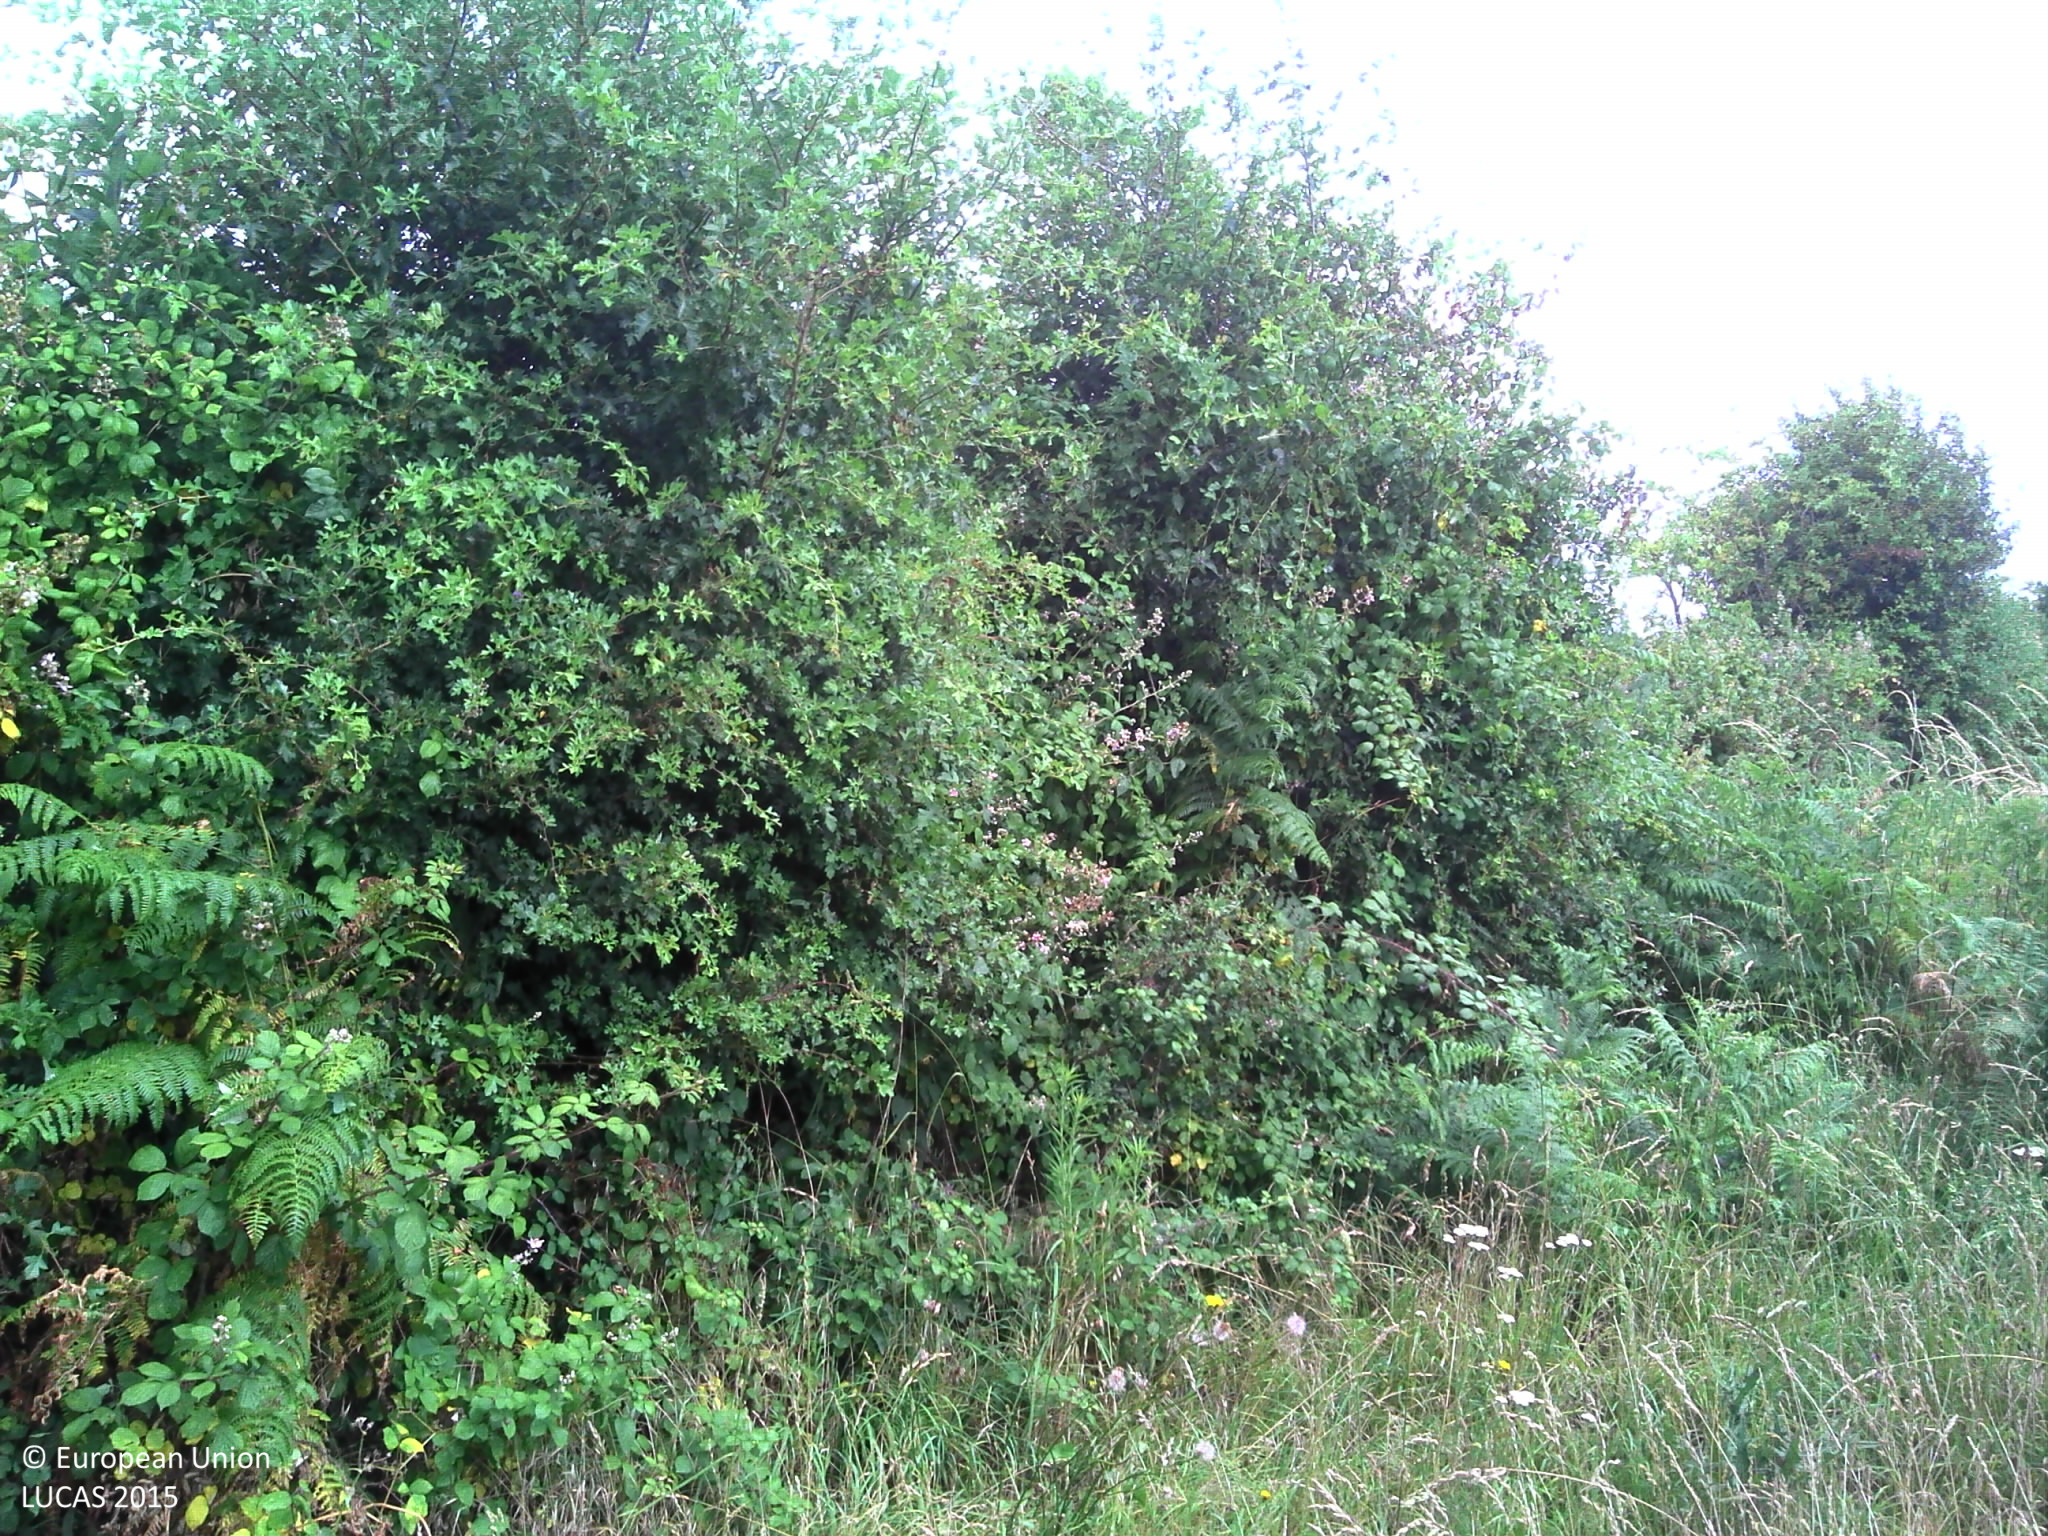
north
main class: Grassland
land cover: Grassland with sparse tree/shrub cover
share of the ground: > 75 %
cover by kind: herbaceous plants 95 %, broadleaved forest trees 5 %
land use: Agriculture (excluding fallow land and kitchen gardens)
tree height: > 5 m
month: July
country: FR
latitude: 47.2663
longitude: -1.7417
